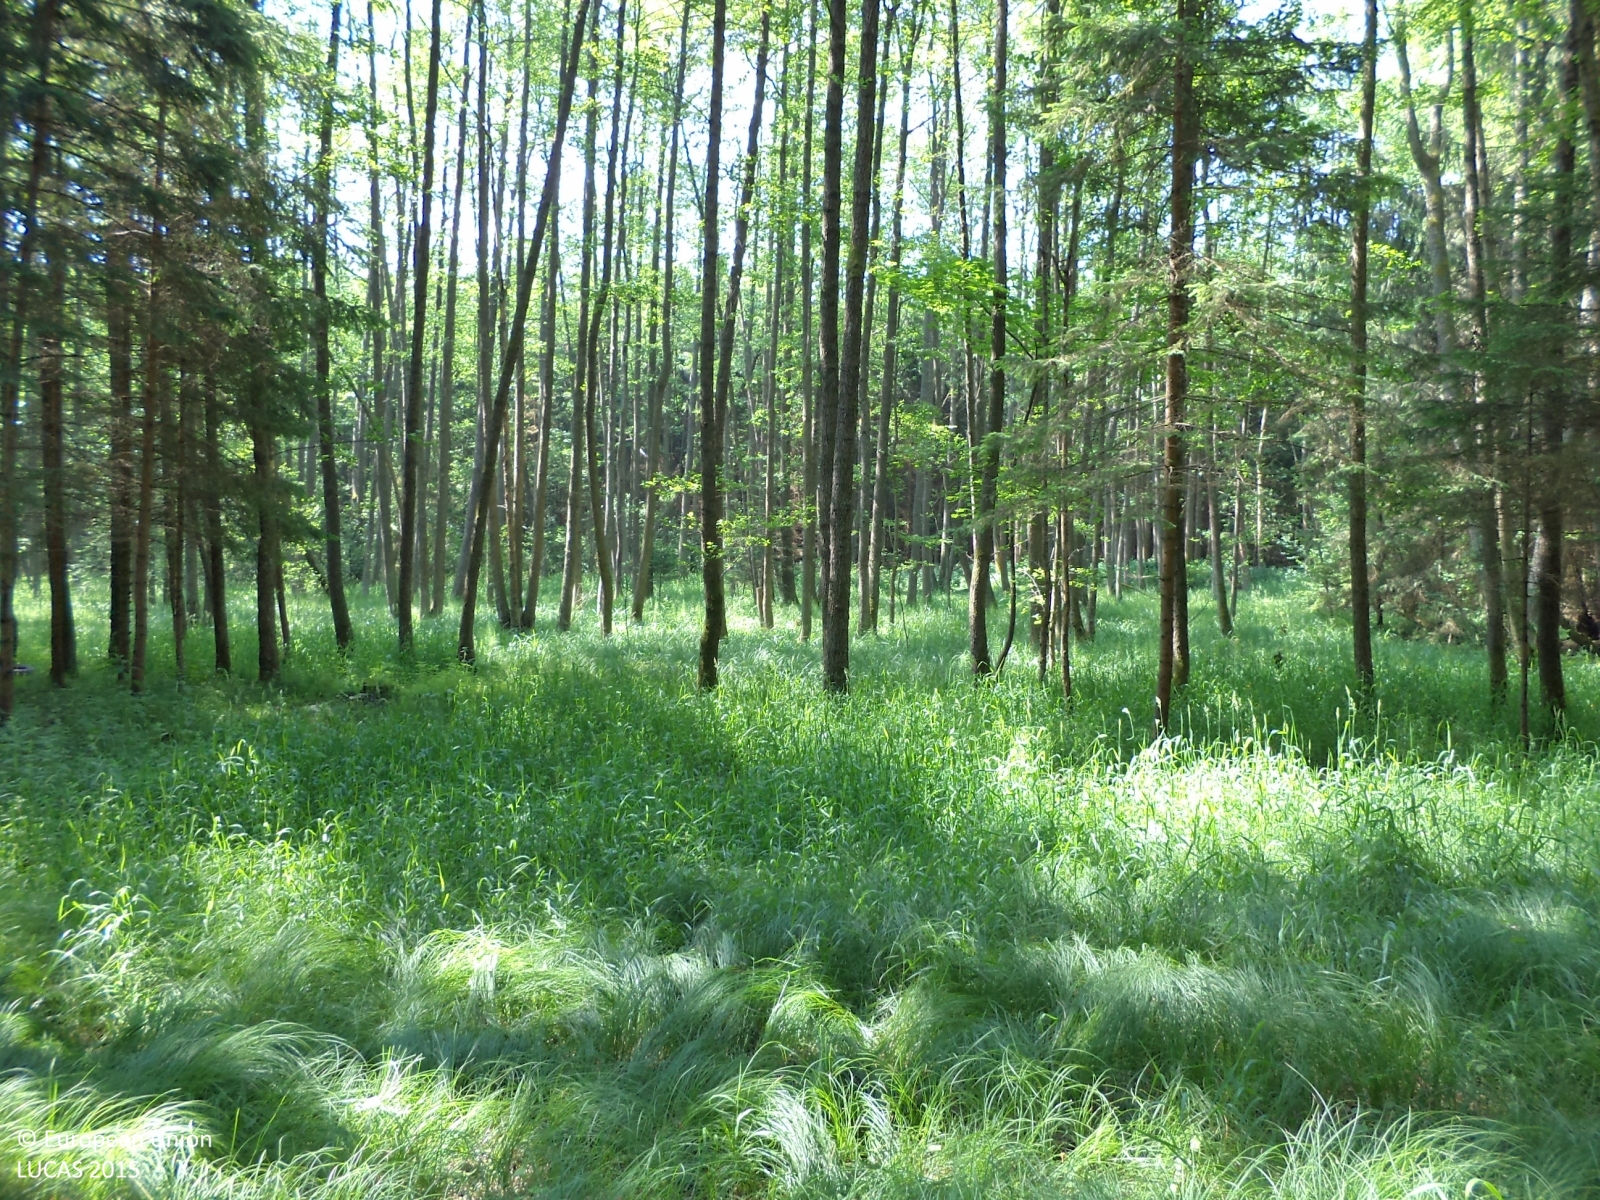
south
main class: Woodland
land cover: Spruce dominated coniferous woodland
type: hemiboreal forest and nemoral coniferous forest and mixed broadleaved-coniferous forest
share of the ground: > 75 %
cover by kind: coniferous forest trees 80 %, herbaceous plants 20 %
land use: Forestry
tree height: > 5 m
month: June
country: CZ
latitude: 49.3421
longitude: 14.4194
